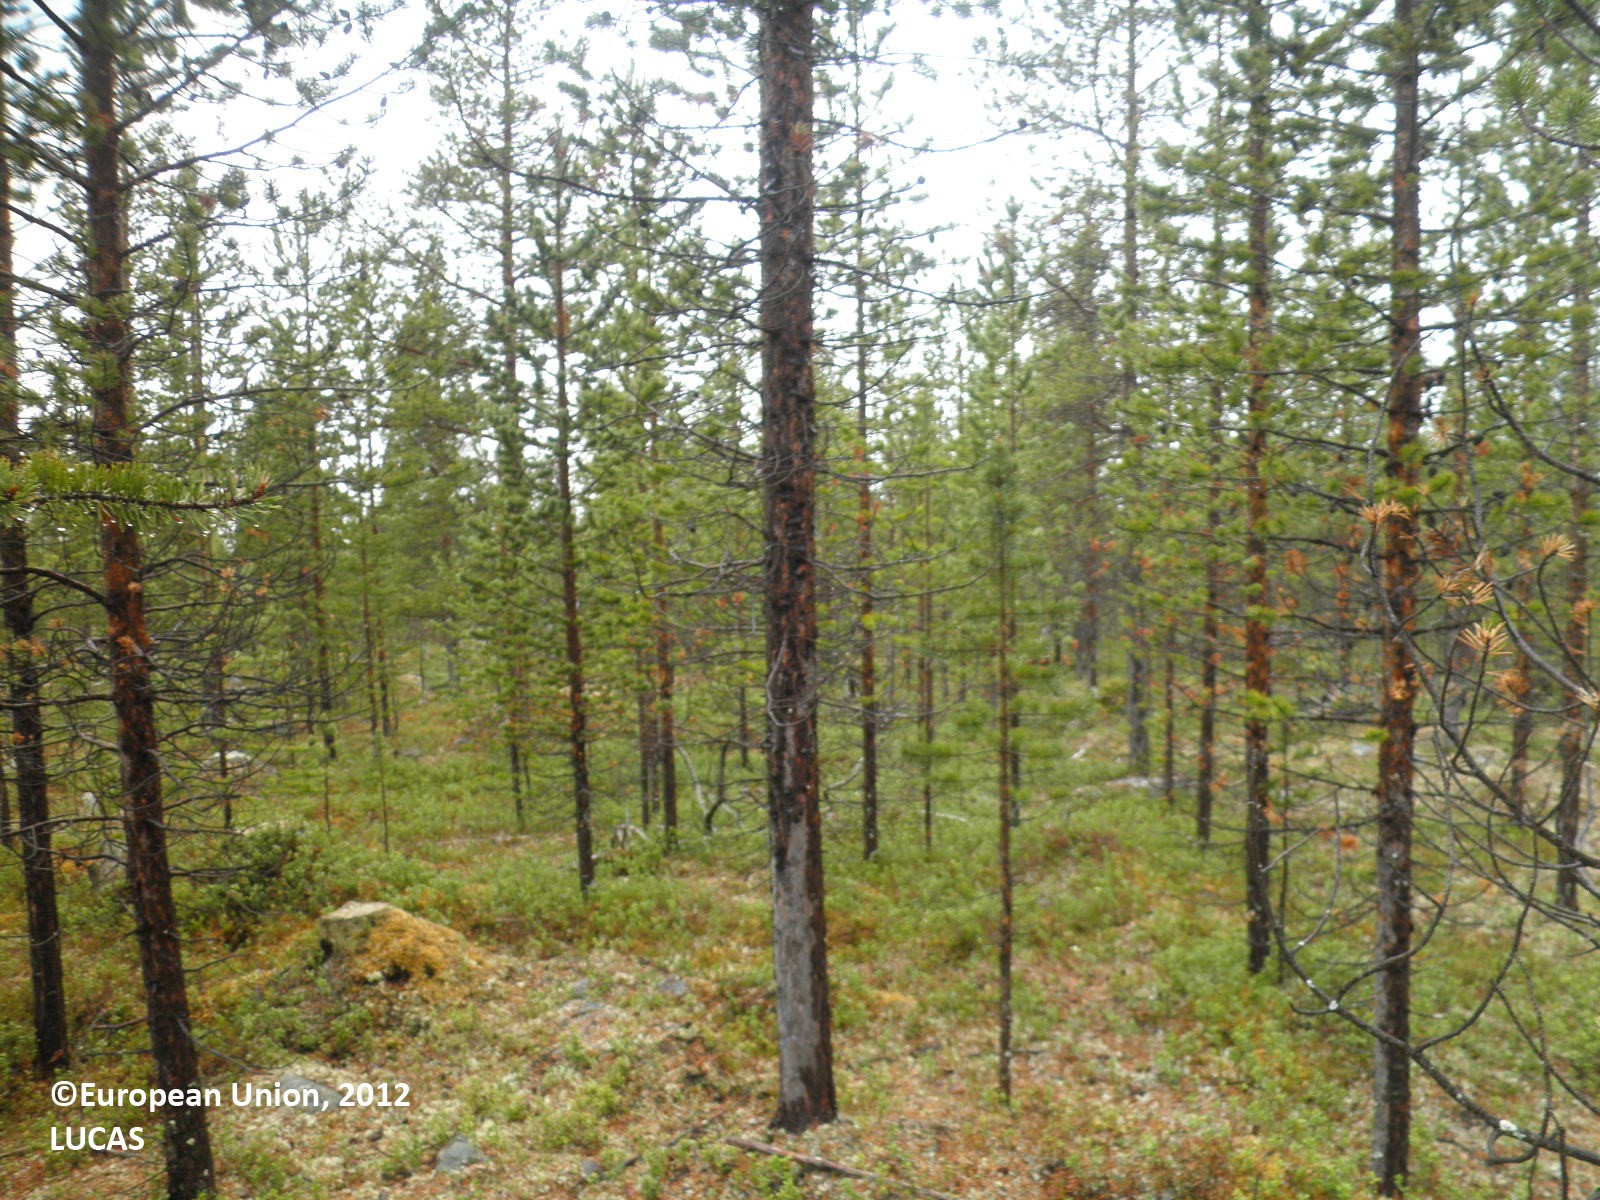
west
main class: Woodland
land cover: Pine dominated coniferous woodland
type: boreal forest
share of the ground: 50 - 75 %
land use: Forestry
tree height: > 5 m
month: June
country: FI
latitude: 68.8978
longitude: 26.7534
